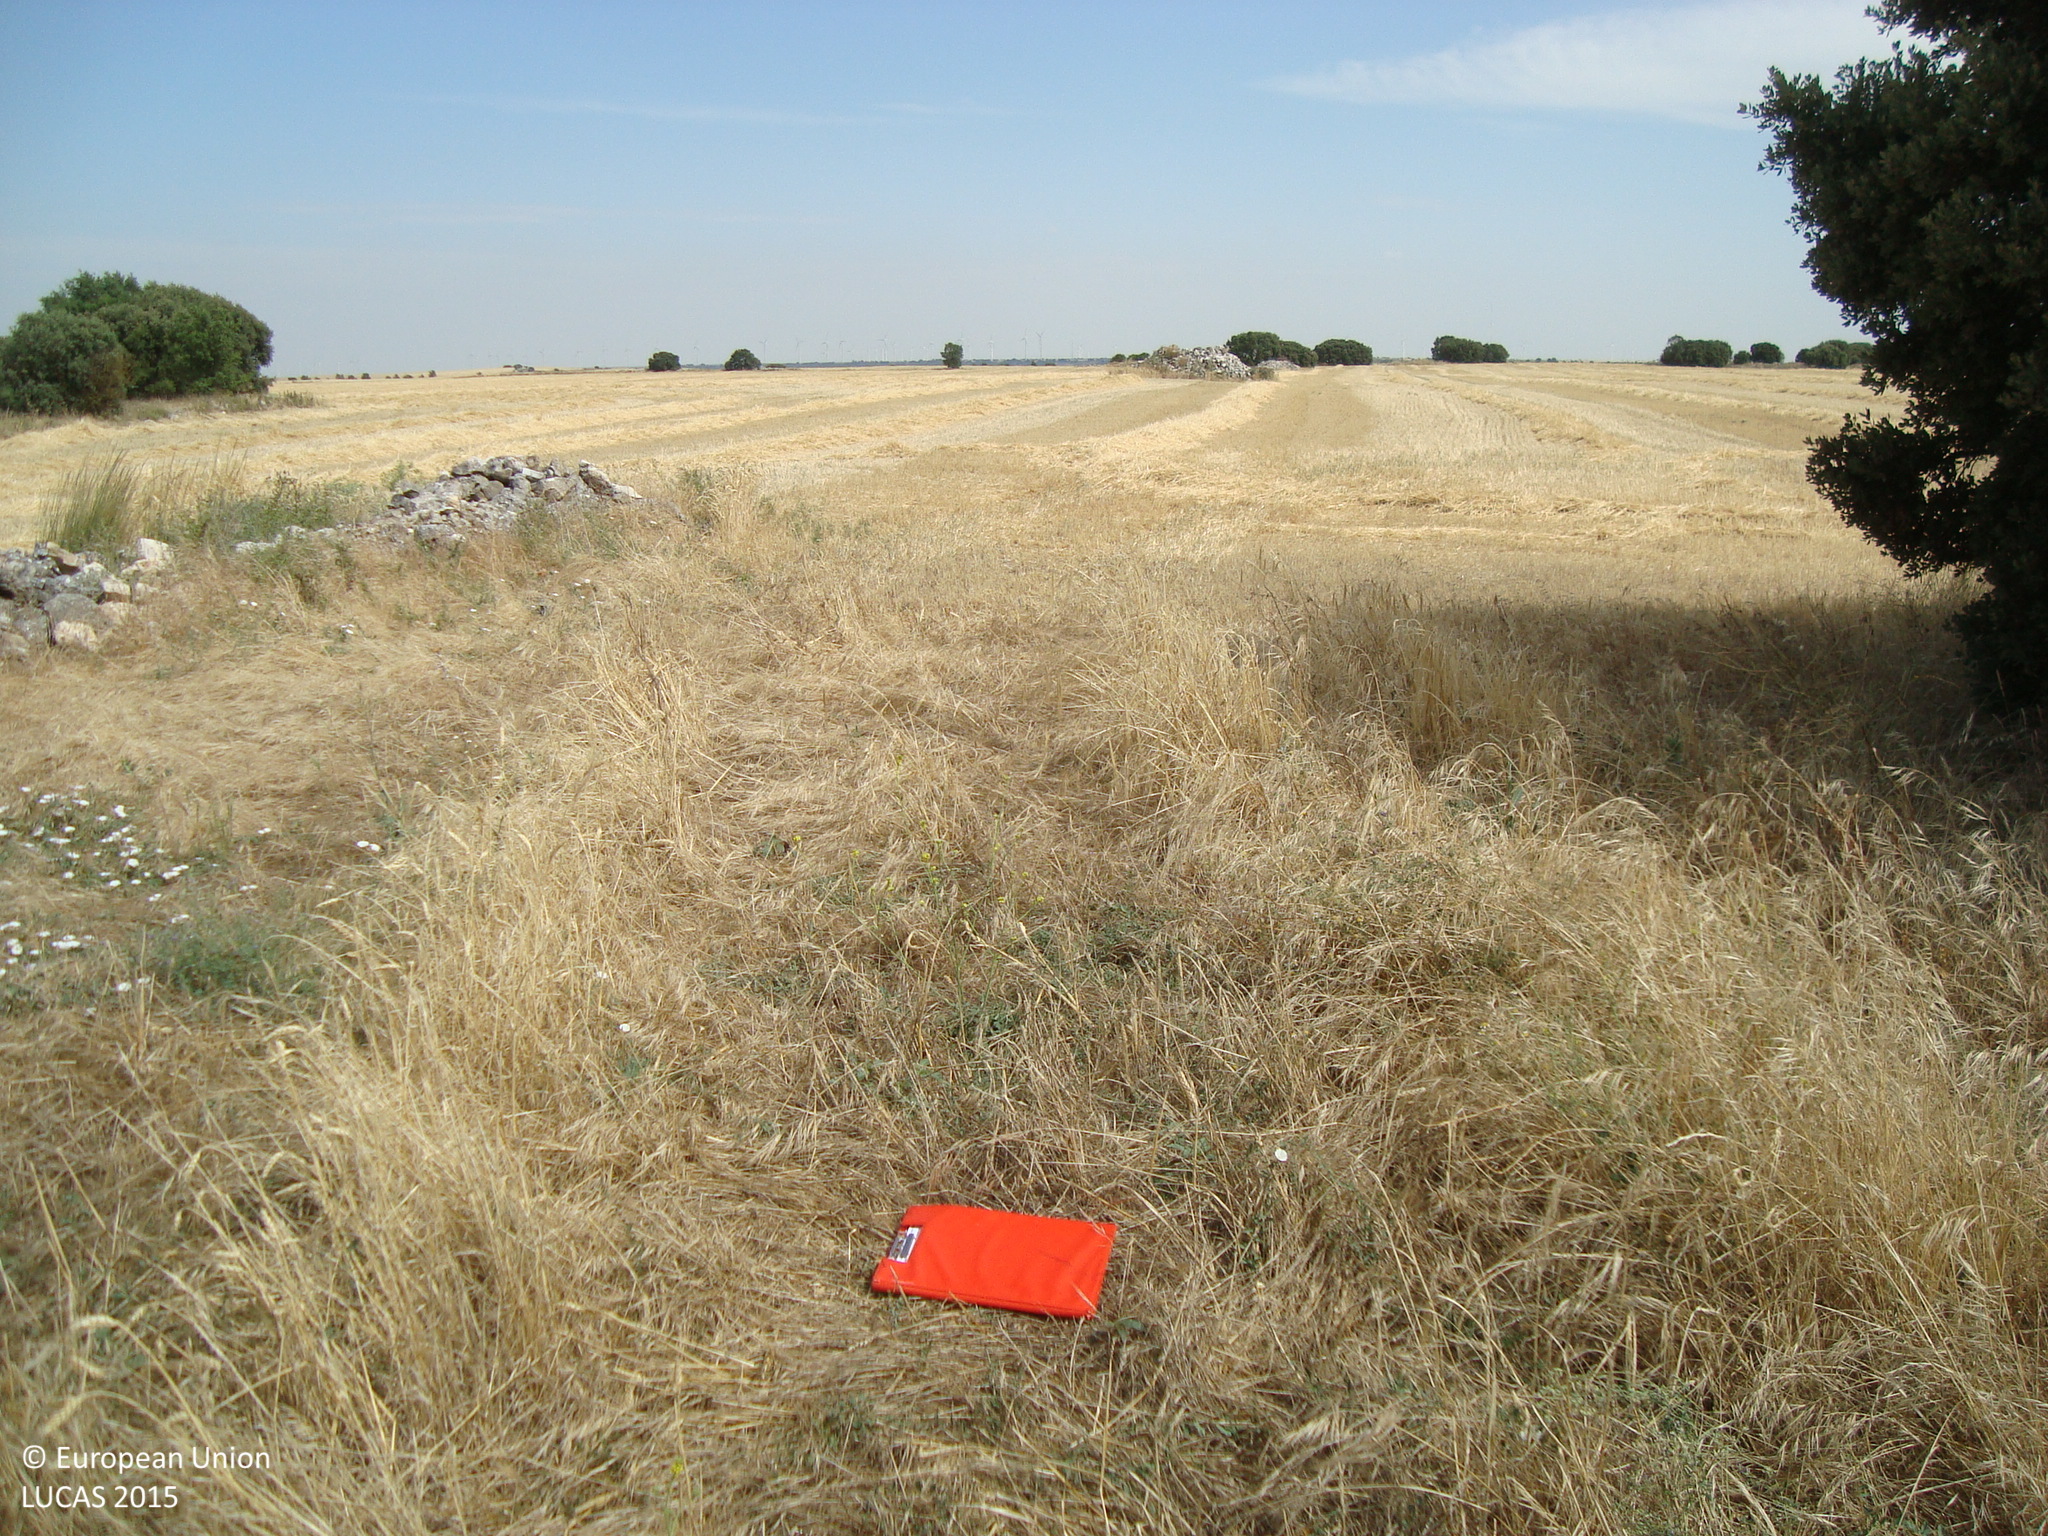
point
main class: Grassland
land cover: Grassland with sparse tree/shrub cover
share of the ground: > 75 %
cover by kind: herbaceous plants 75 %, broadleaved forest trees 5 %, shrubs 5 %
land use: Agriculture (excluding fallow land and kitchen gardens)
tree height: > 5 m
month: July
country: ES
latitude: 41.9002
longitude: -4.2272
